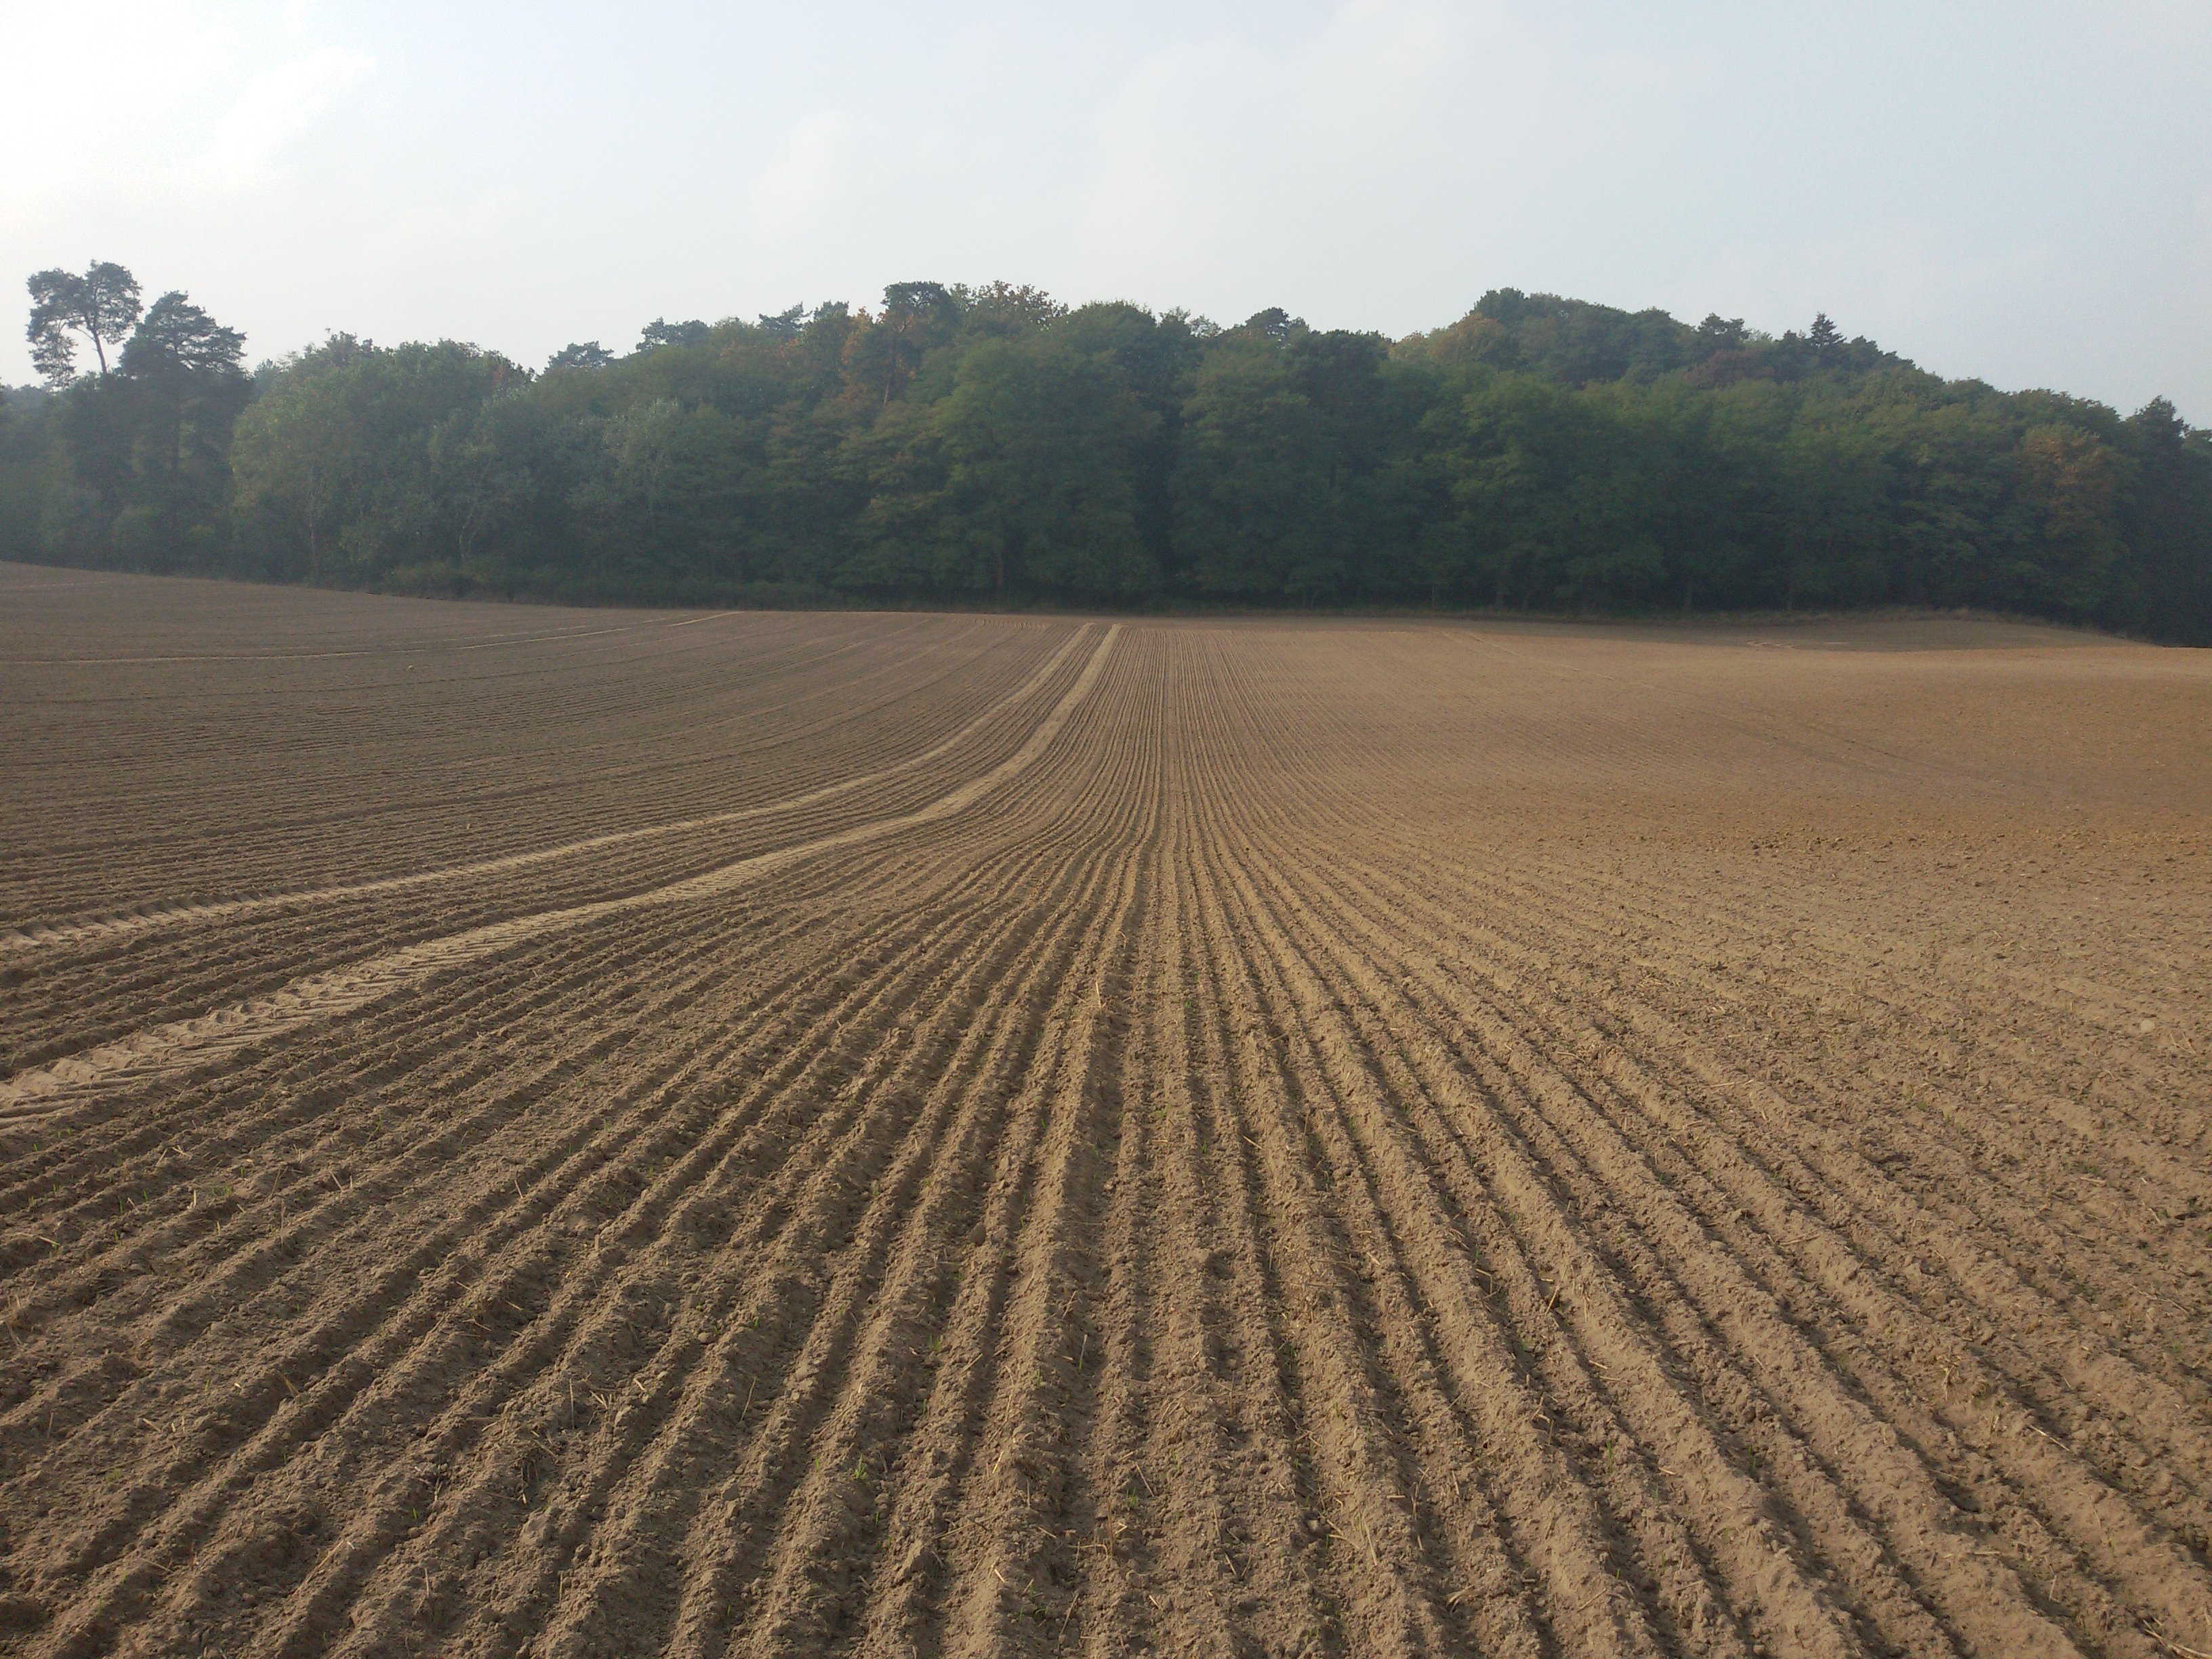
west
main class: Cropland
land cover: Barley
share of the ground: < 10 %
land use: Agriculture (excluding fallow land and kitchen gardens)
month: October
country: PL
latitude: 53.1574
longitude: 14.4728
